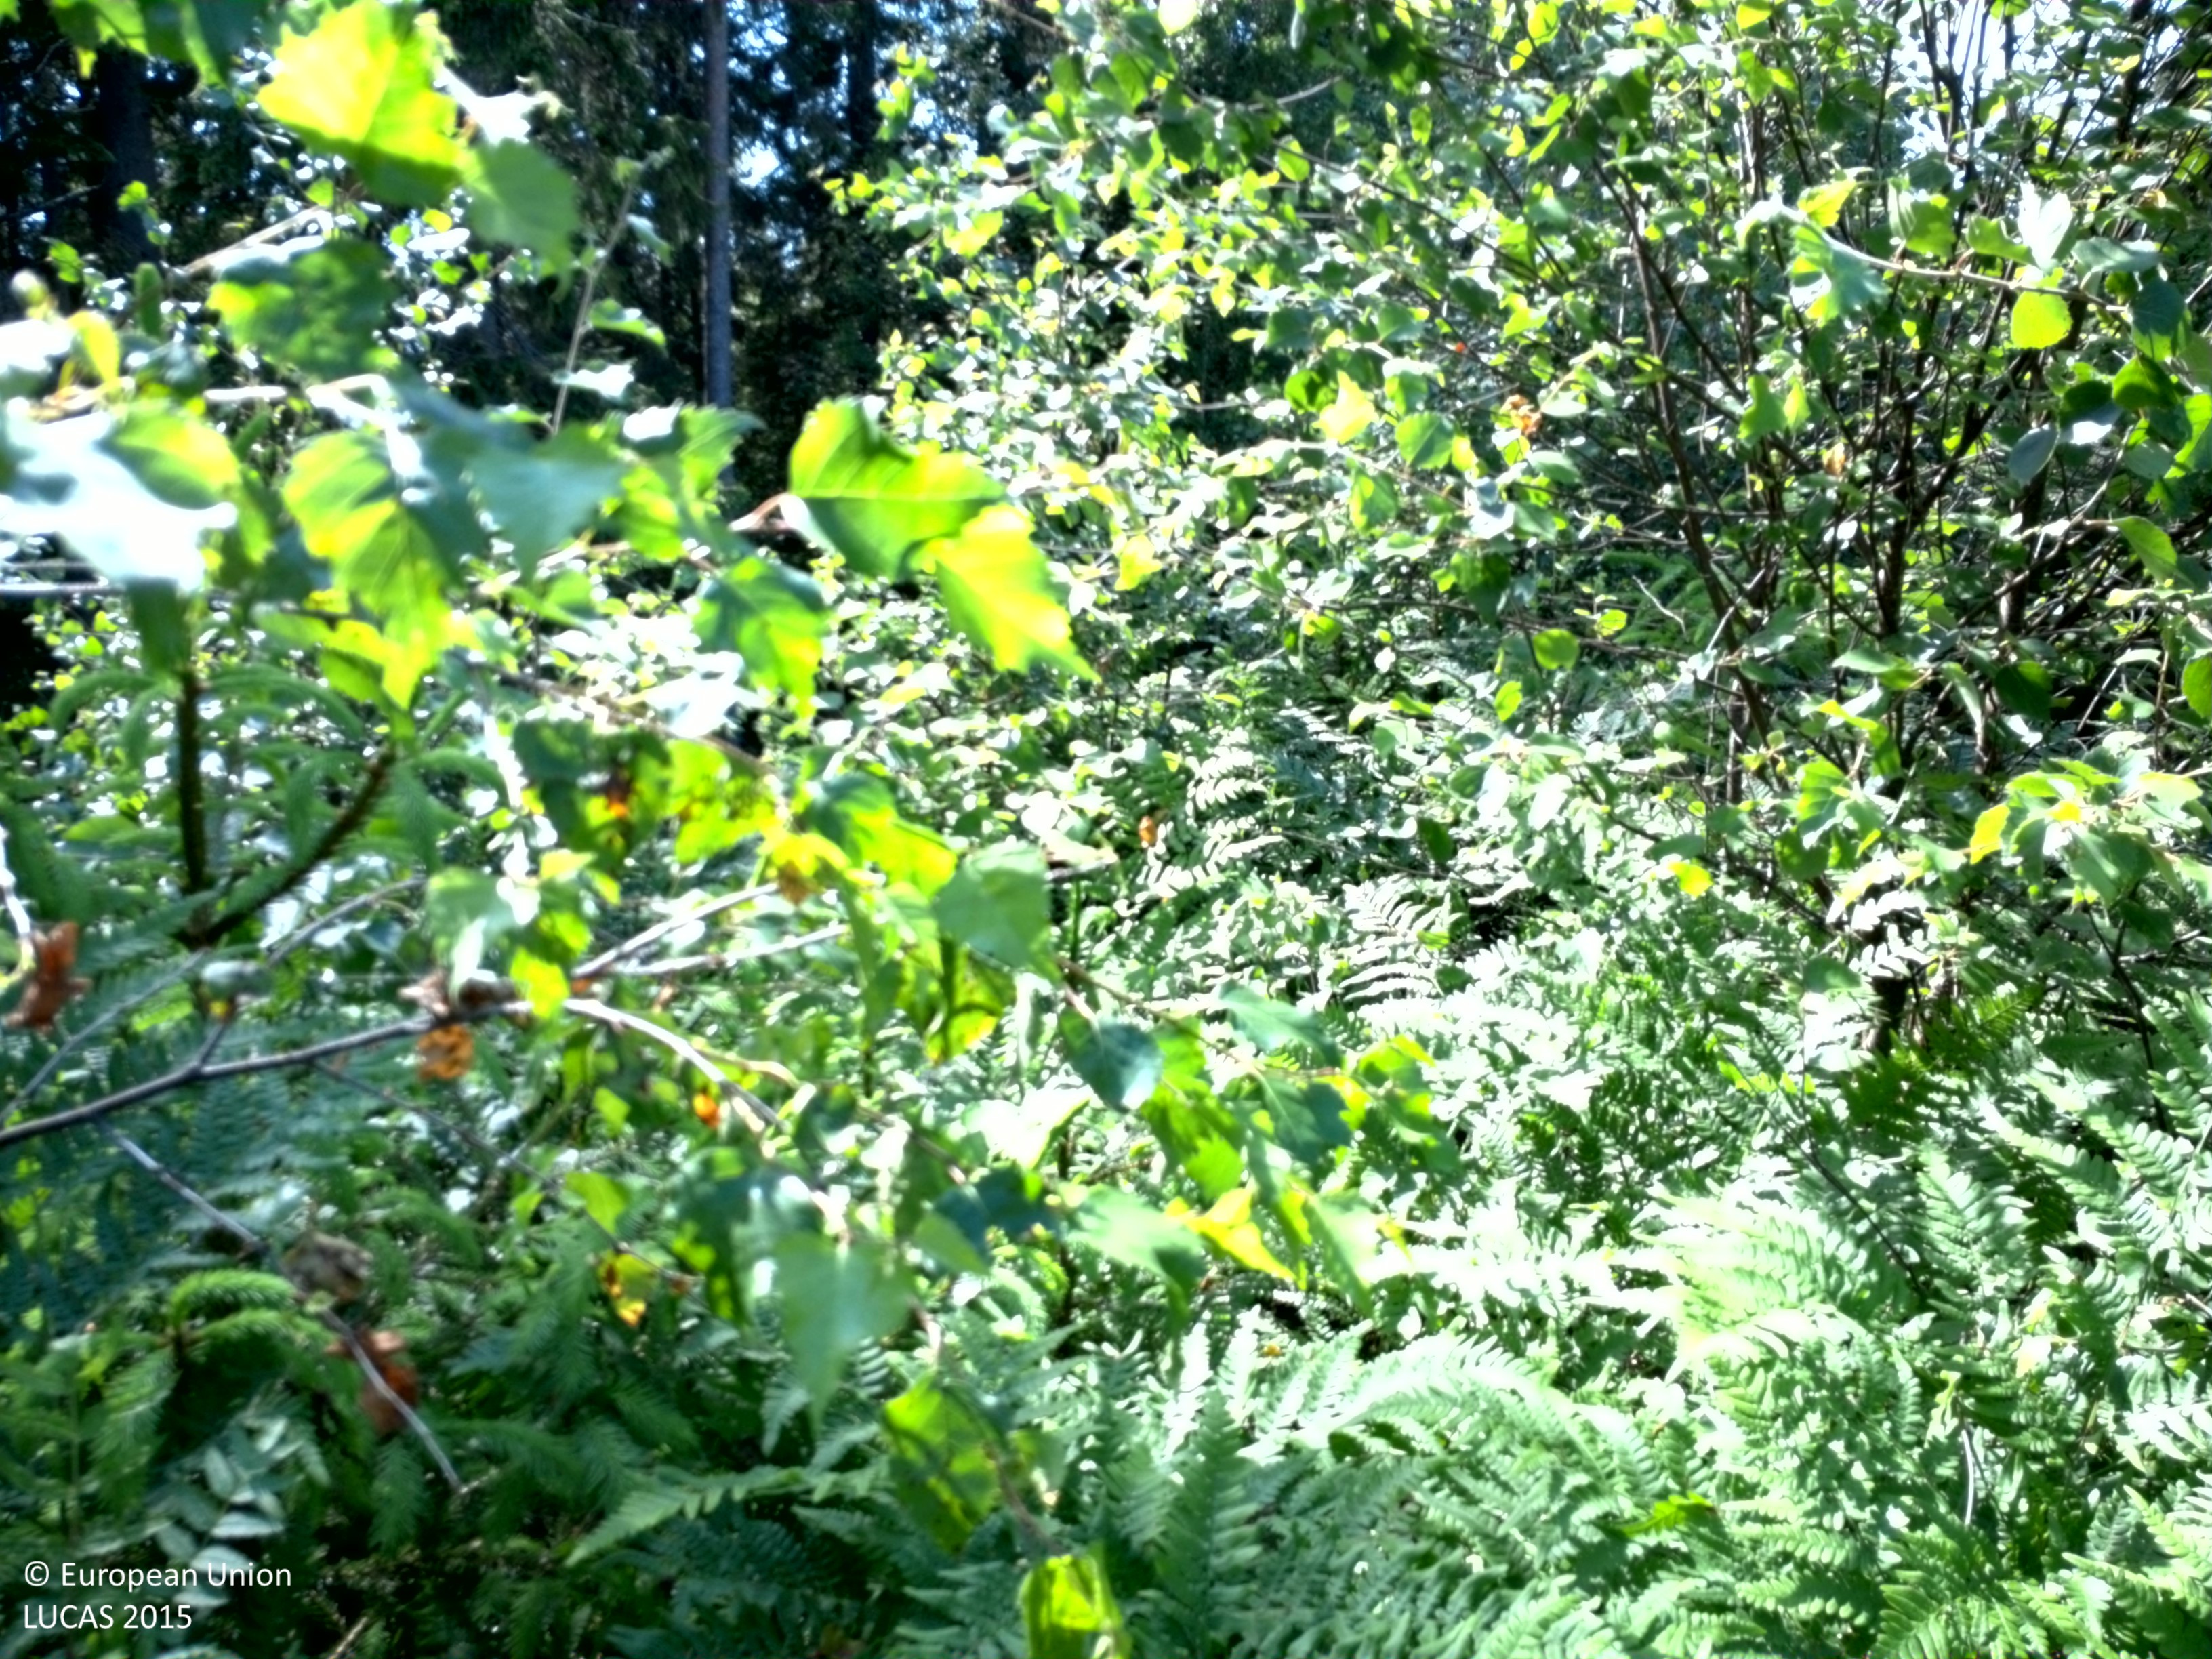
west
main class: Woodland
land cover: Spruce dominated mixed woodland
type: boreal forest
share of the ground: 50 - 75 %
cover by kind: herbaceous plants 40 %, coniferous forest trees 35 %, broadleaved forest trees 25 %
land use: Forestry
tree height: < 5 m
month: July
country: SE
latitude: 58.8227
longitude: 14.6860
